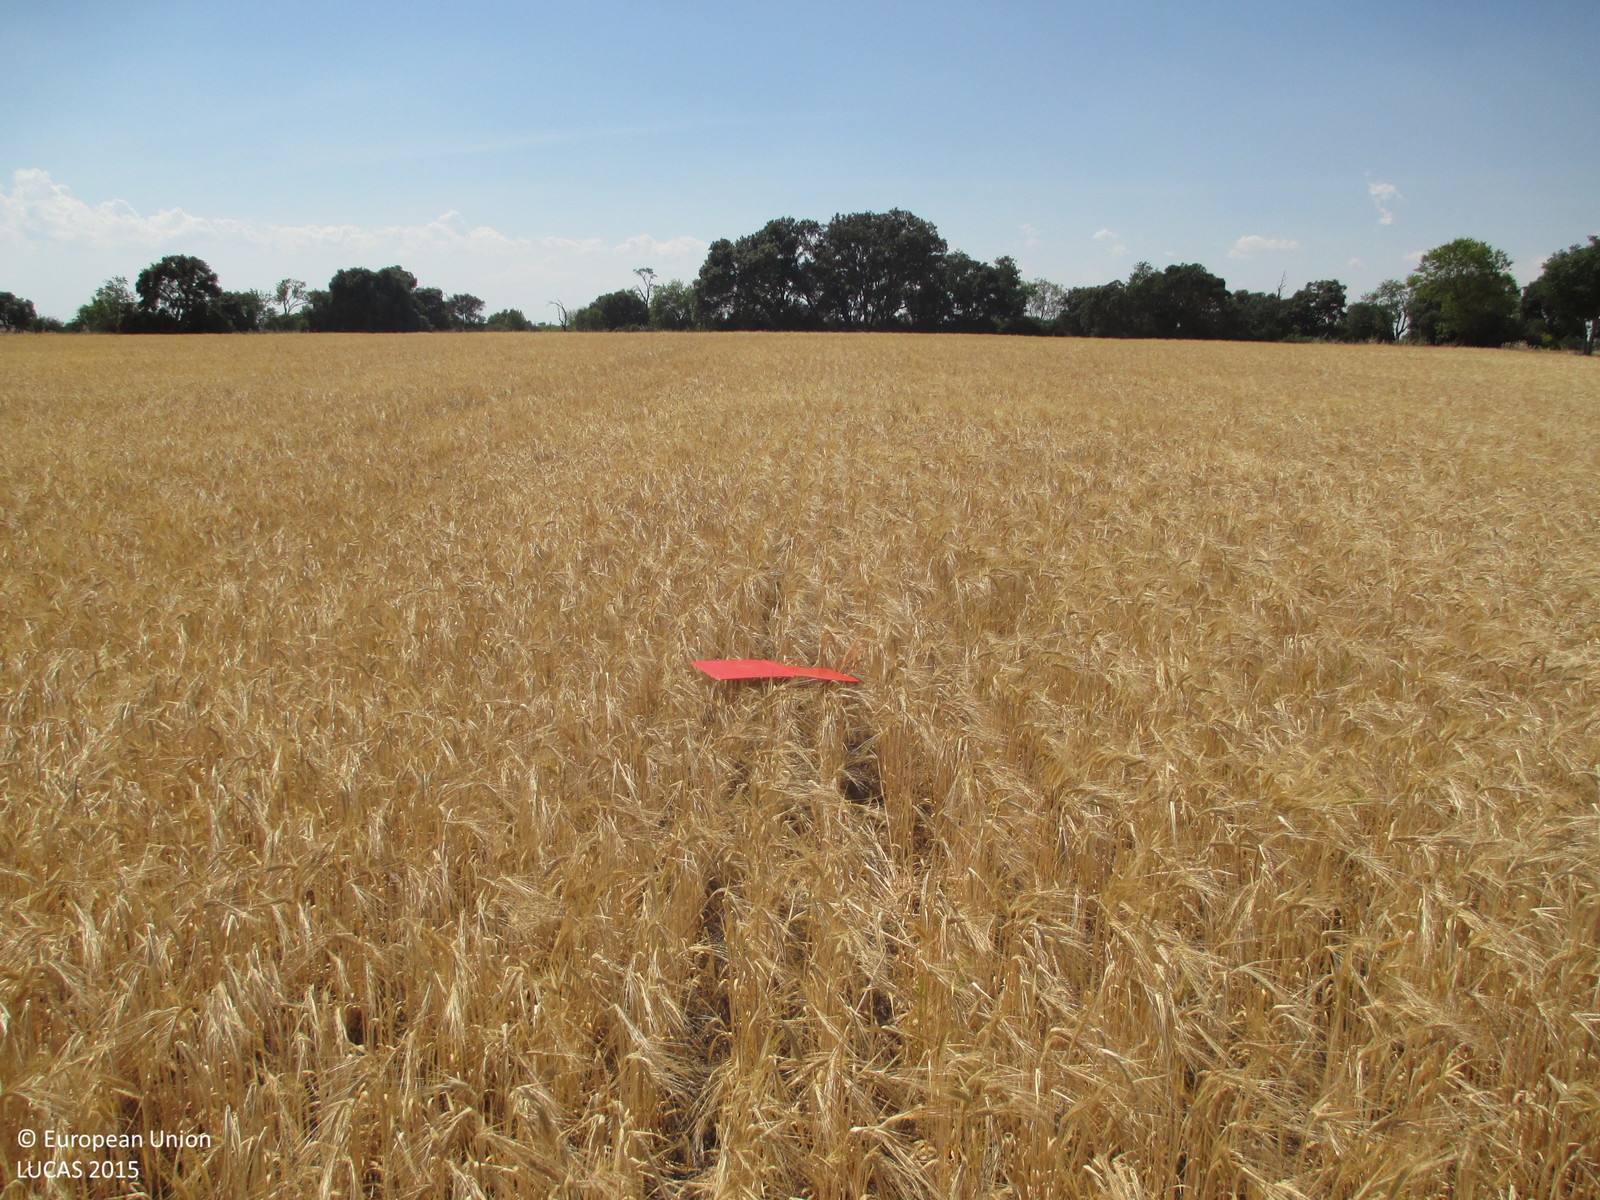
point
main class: Cropland
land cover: Barley
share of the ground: > 75 %
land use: Agriculture (excluding fallow land and kitchen gardens)
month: May
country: ES
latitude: 41.9225
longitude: 0.0099
